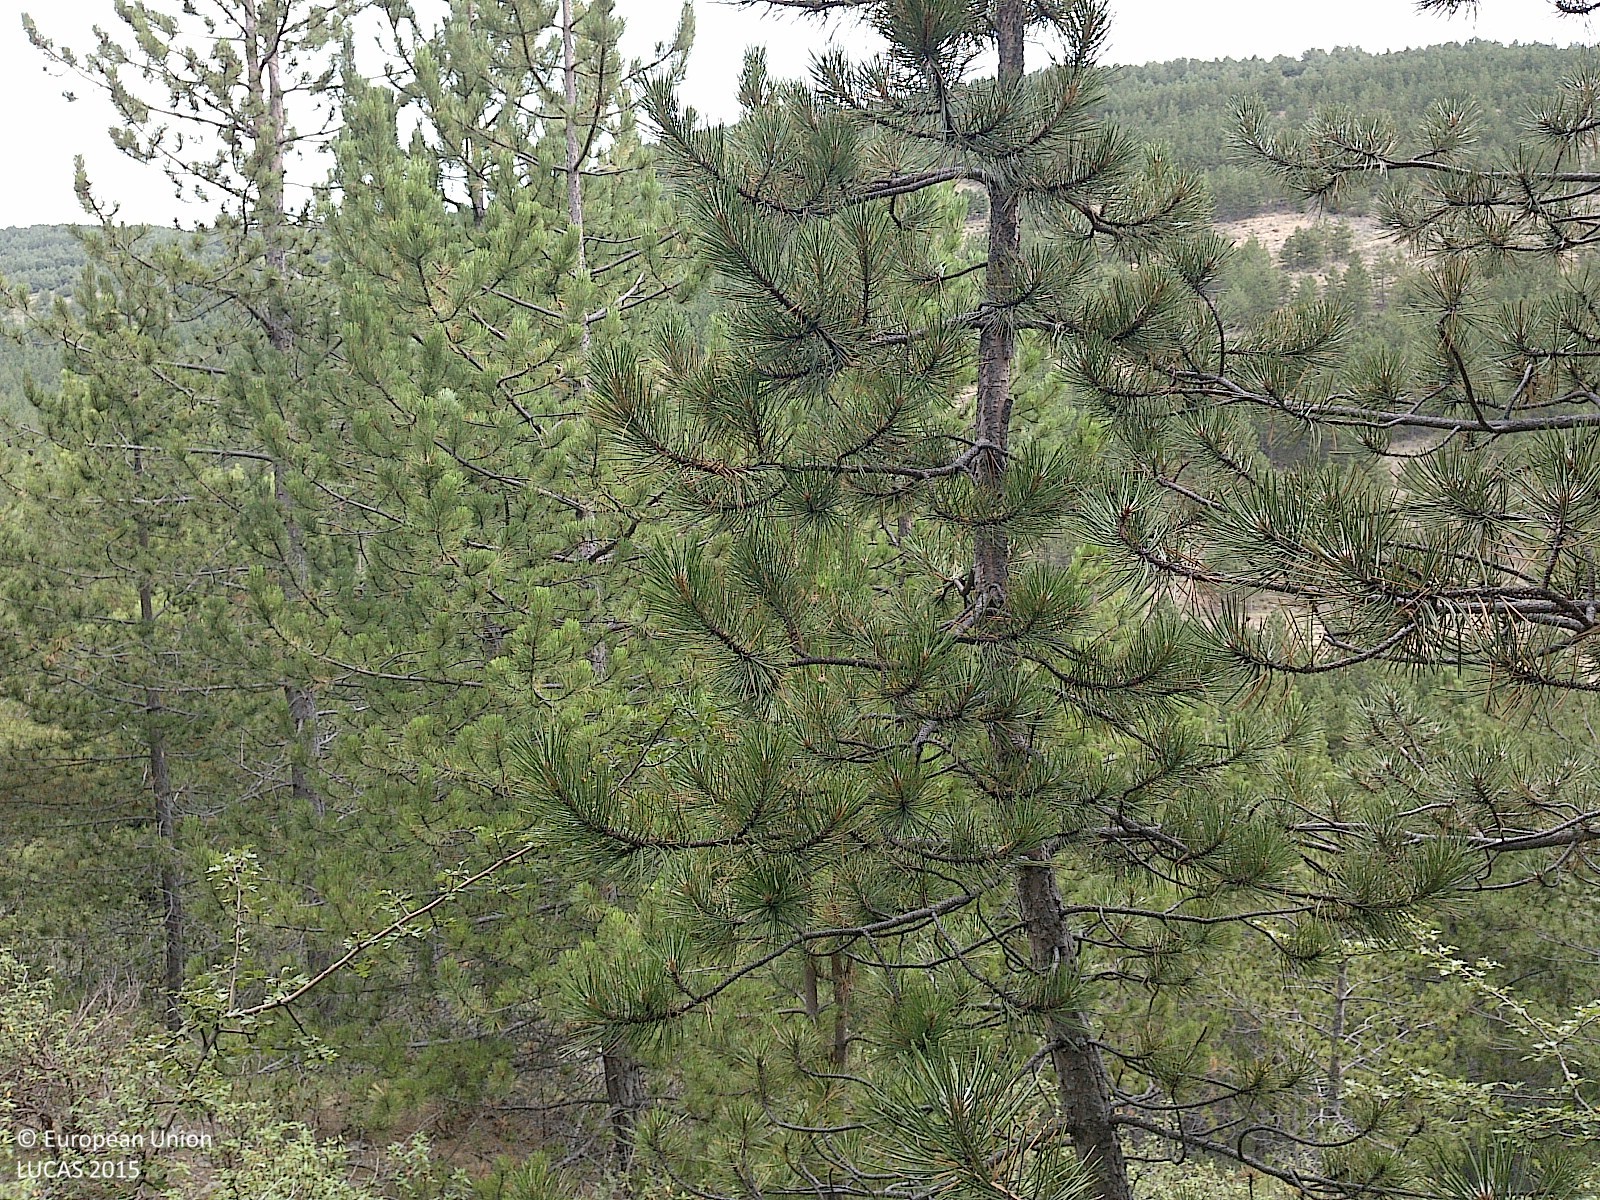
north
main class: Woodland
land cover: Pine dominated coniferous woodland
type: coniferous forest of the mediterranean region
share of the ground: 50 - 75 %
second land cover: Grassland without tree/shrub cover
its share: 25 - 50 %
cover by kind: coniferous forest trees 65 %, shrubs 15 %, herbaceous plants 15 %, consolidated bare surface 5 %
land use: Forestry
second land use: Agriculture (excluding fallow land and kitchen gardens)
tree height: > 5 m
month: July
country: ES
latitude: 42.0736
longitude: -2.2340
